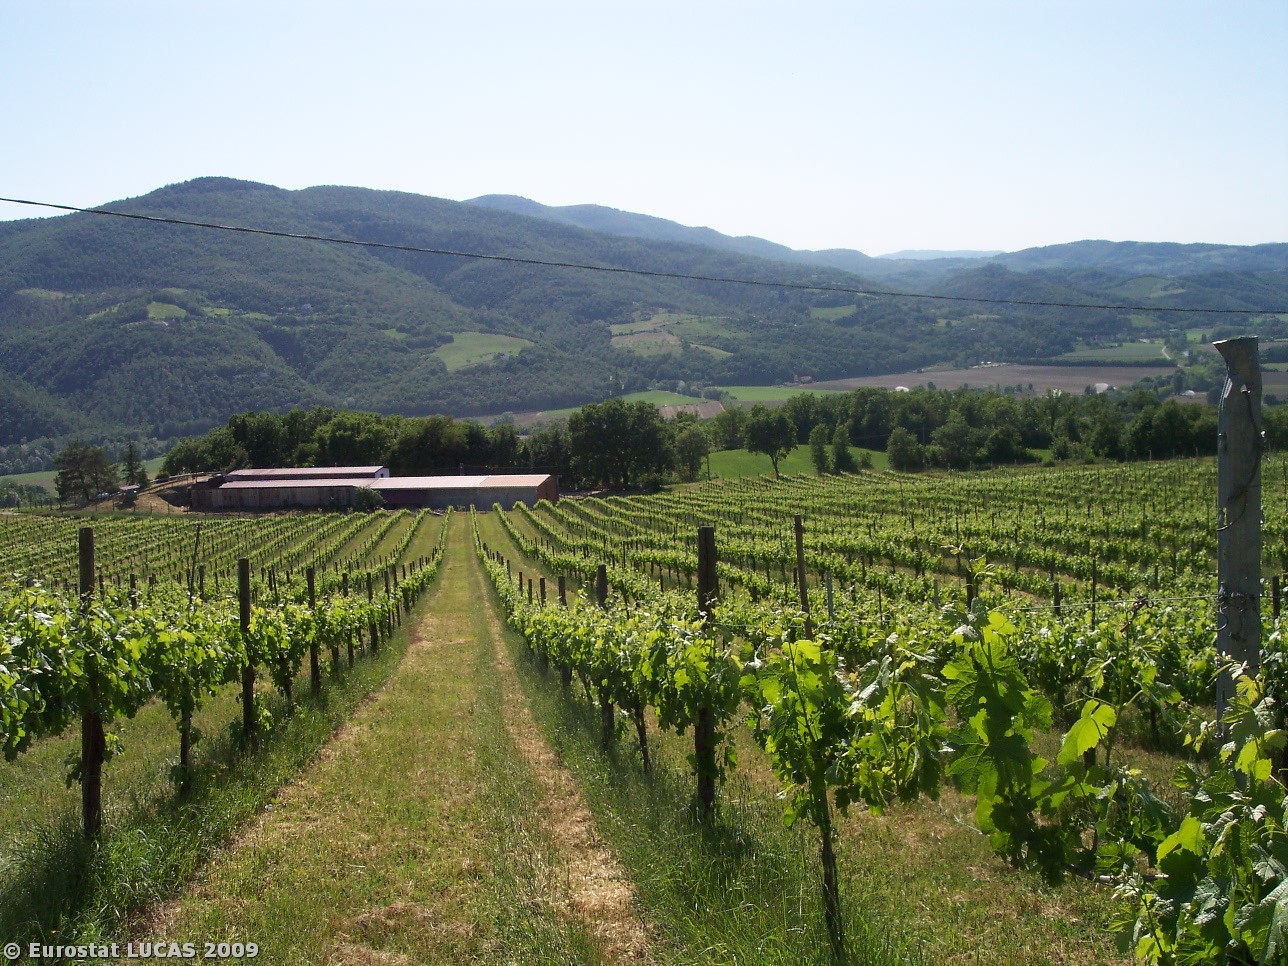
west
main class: Cropland
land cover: Vineyards
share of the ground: 25 - 50 %
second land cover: Grassland with sparse tree/shrub cover
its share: > 75 %
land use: Agriculture (excluding fallow land and kitchen gardens)
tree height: < 5 m
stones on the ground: < 10 %
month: May
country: IT
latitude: 43.2760
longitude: 12.3961
